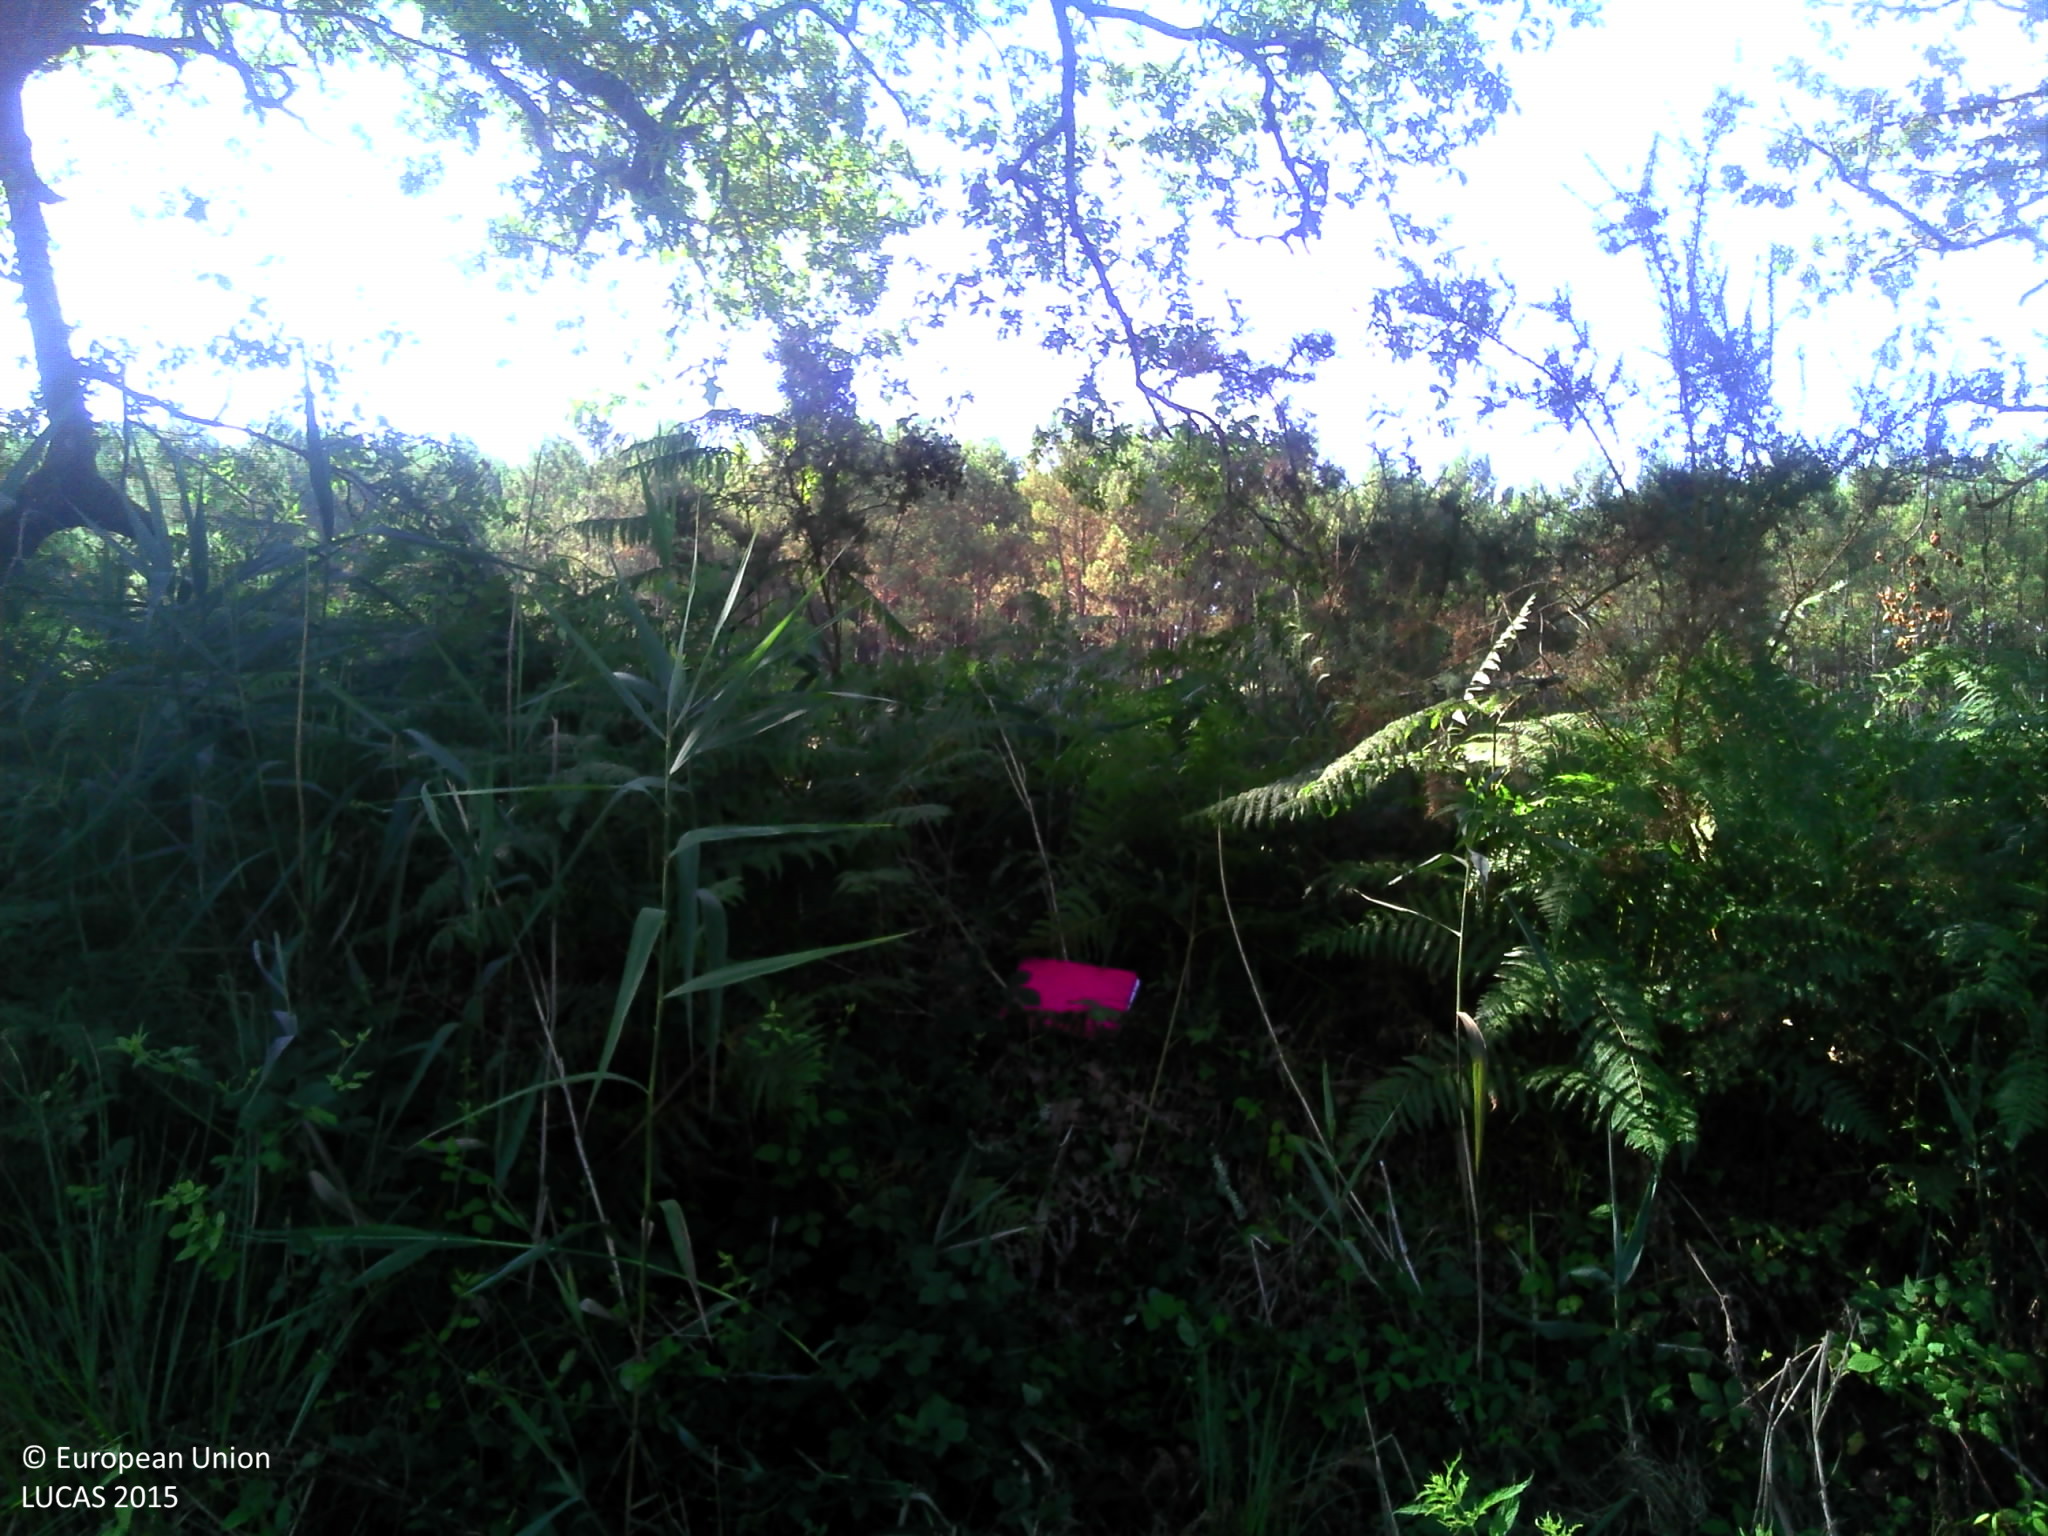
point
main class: Woodland
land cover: Broadleaved woodland
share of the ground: > 75 %
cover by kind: broadleaved forest trees 50 %, herbaceous plants 40 %, shrubs 10 %
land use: Semi-natural and natural areas not in use
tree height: > 5 m
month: July
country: FR
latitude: 43.8988
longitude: -0.5825
